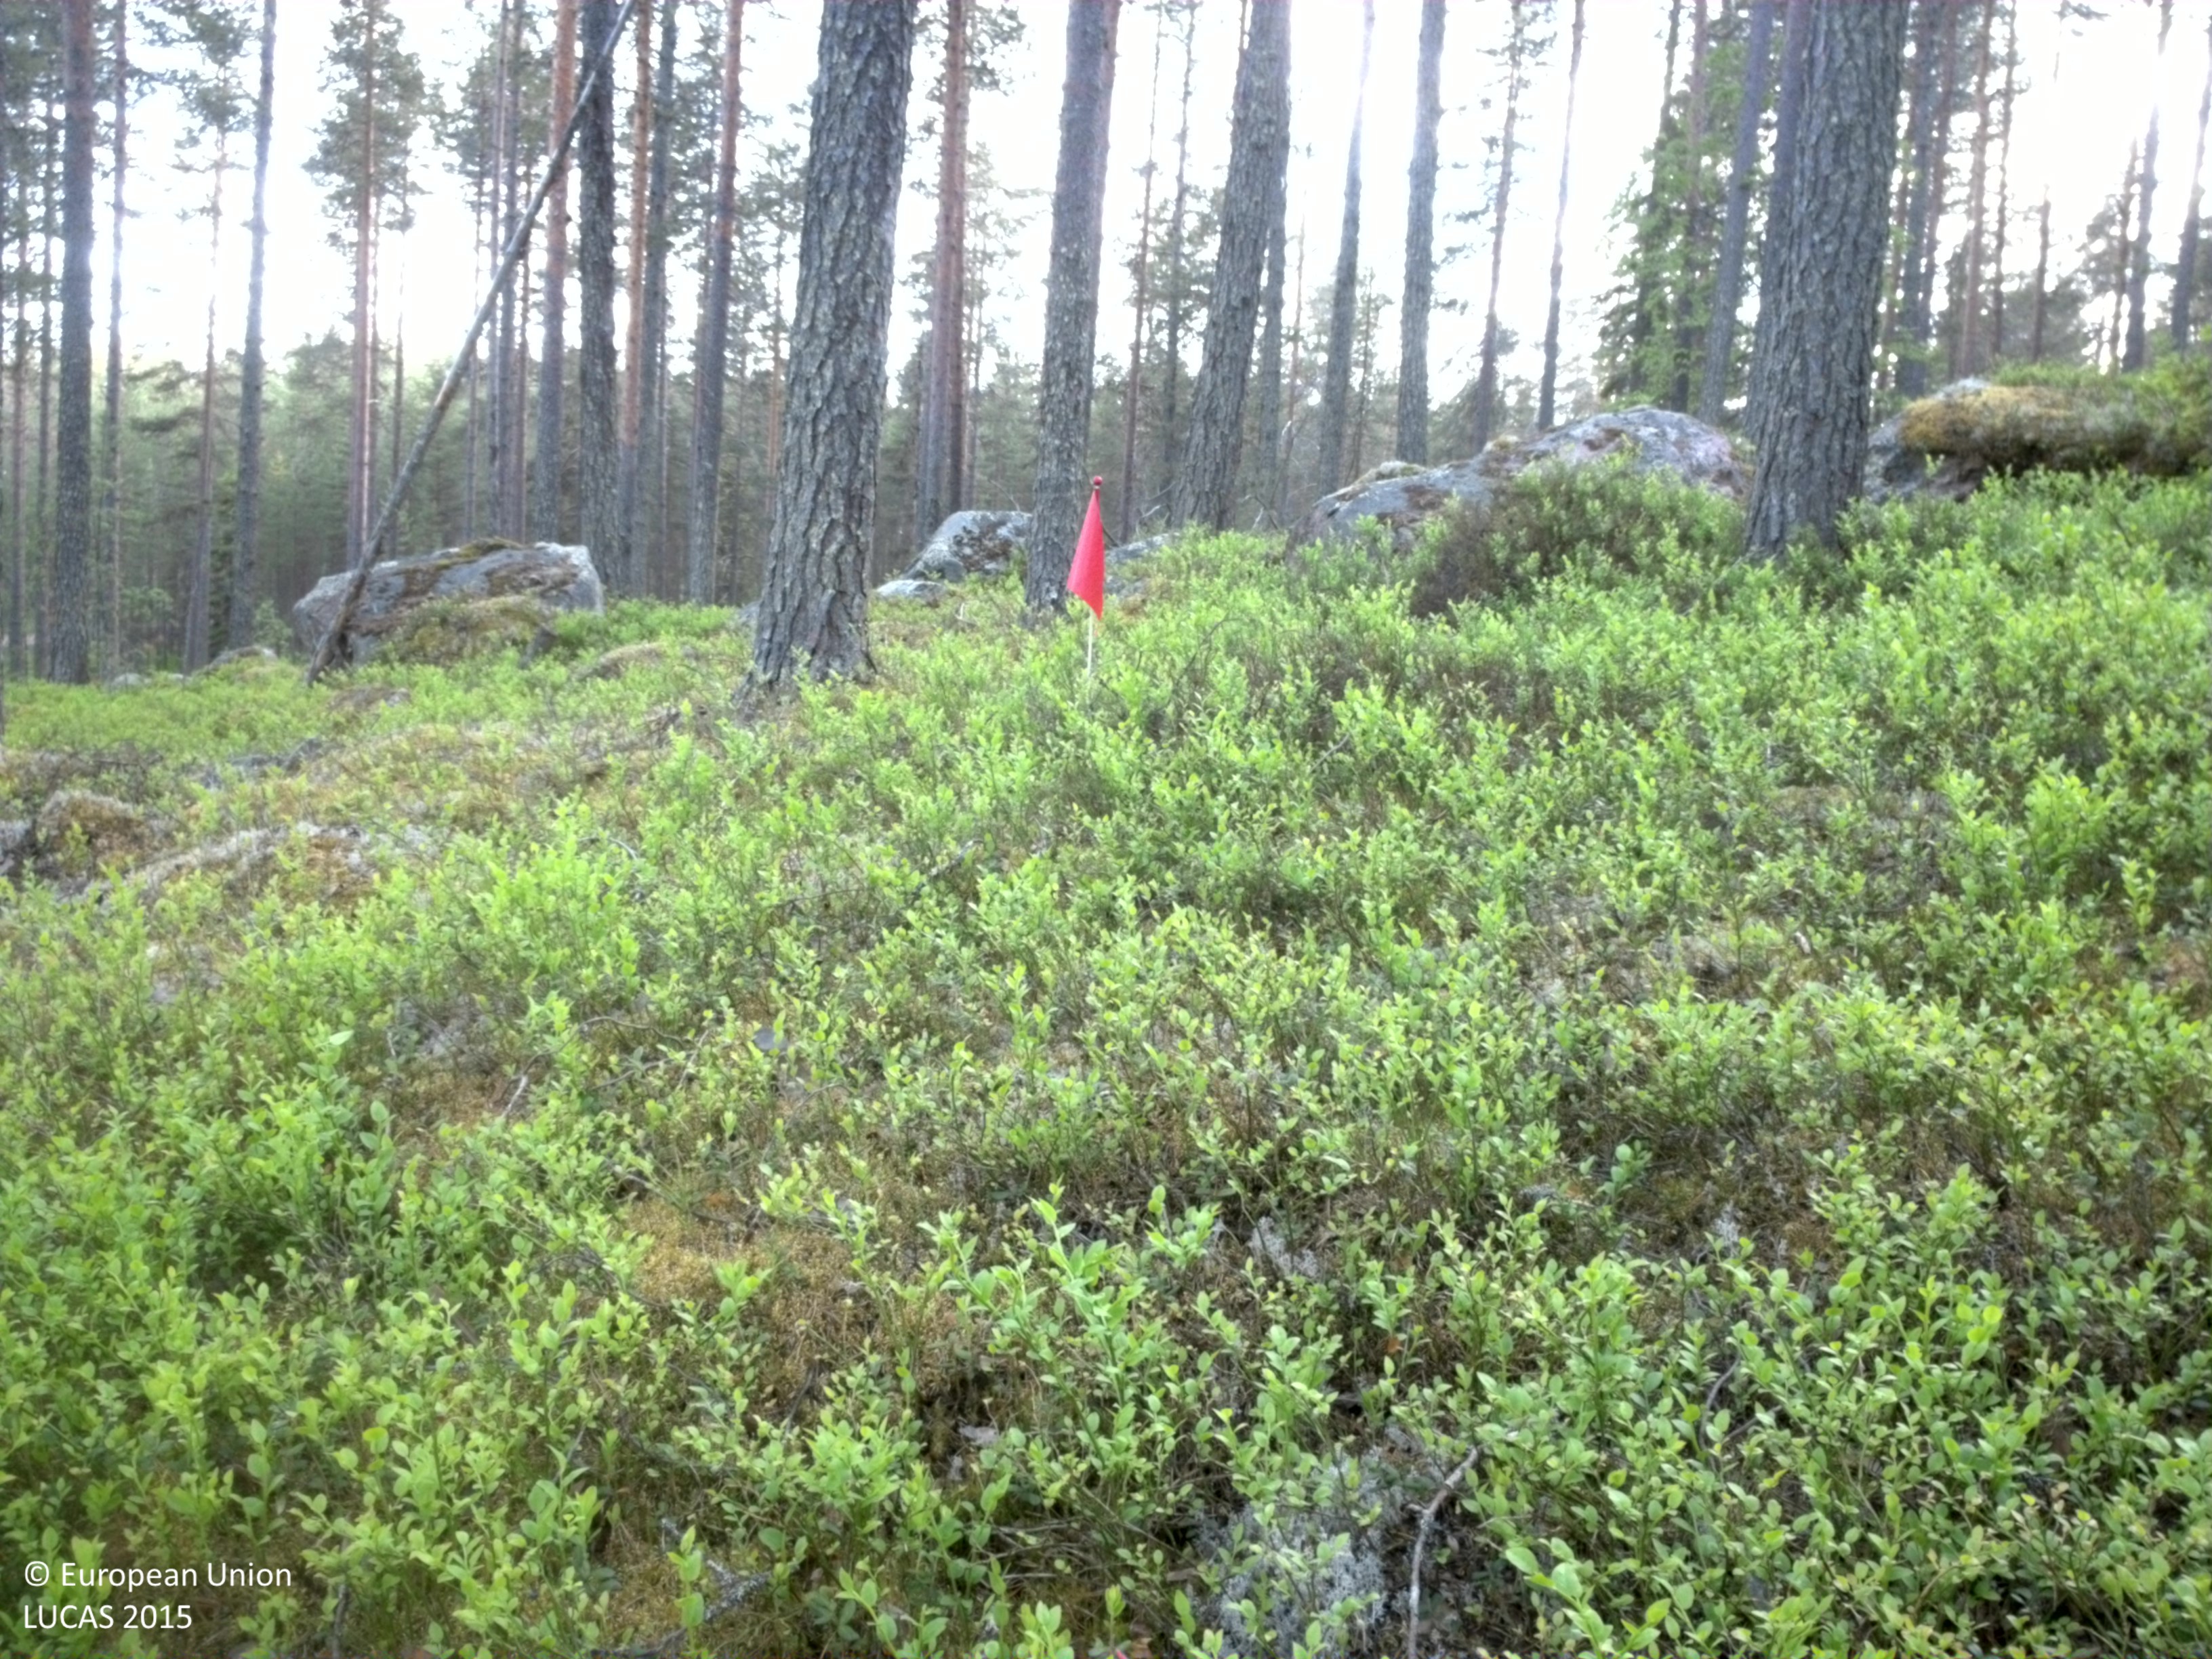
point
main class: Woodland
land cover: Pine dominated coniferous woodland
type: boreal forest
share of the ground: 25 - 50 %
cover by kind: shrubs 50 %, coniferous forest trees 40 %, consolidated bare surface 10 %
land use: Forestry
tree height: > 5 m
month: June
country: SE
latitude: 66.3019
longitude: 22.7985
